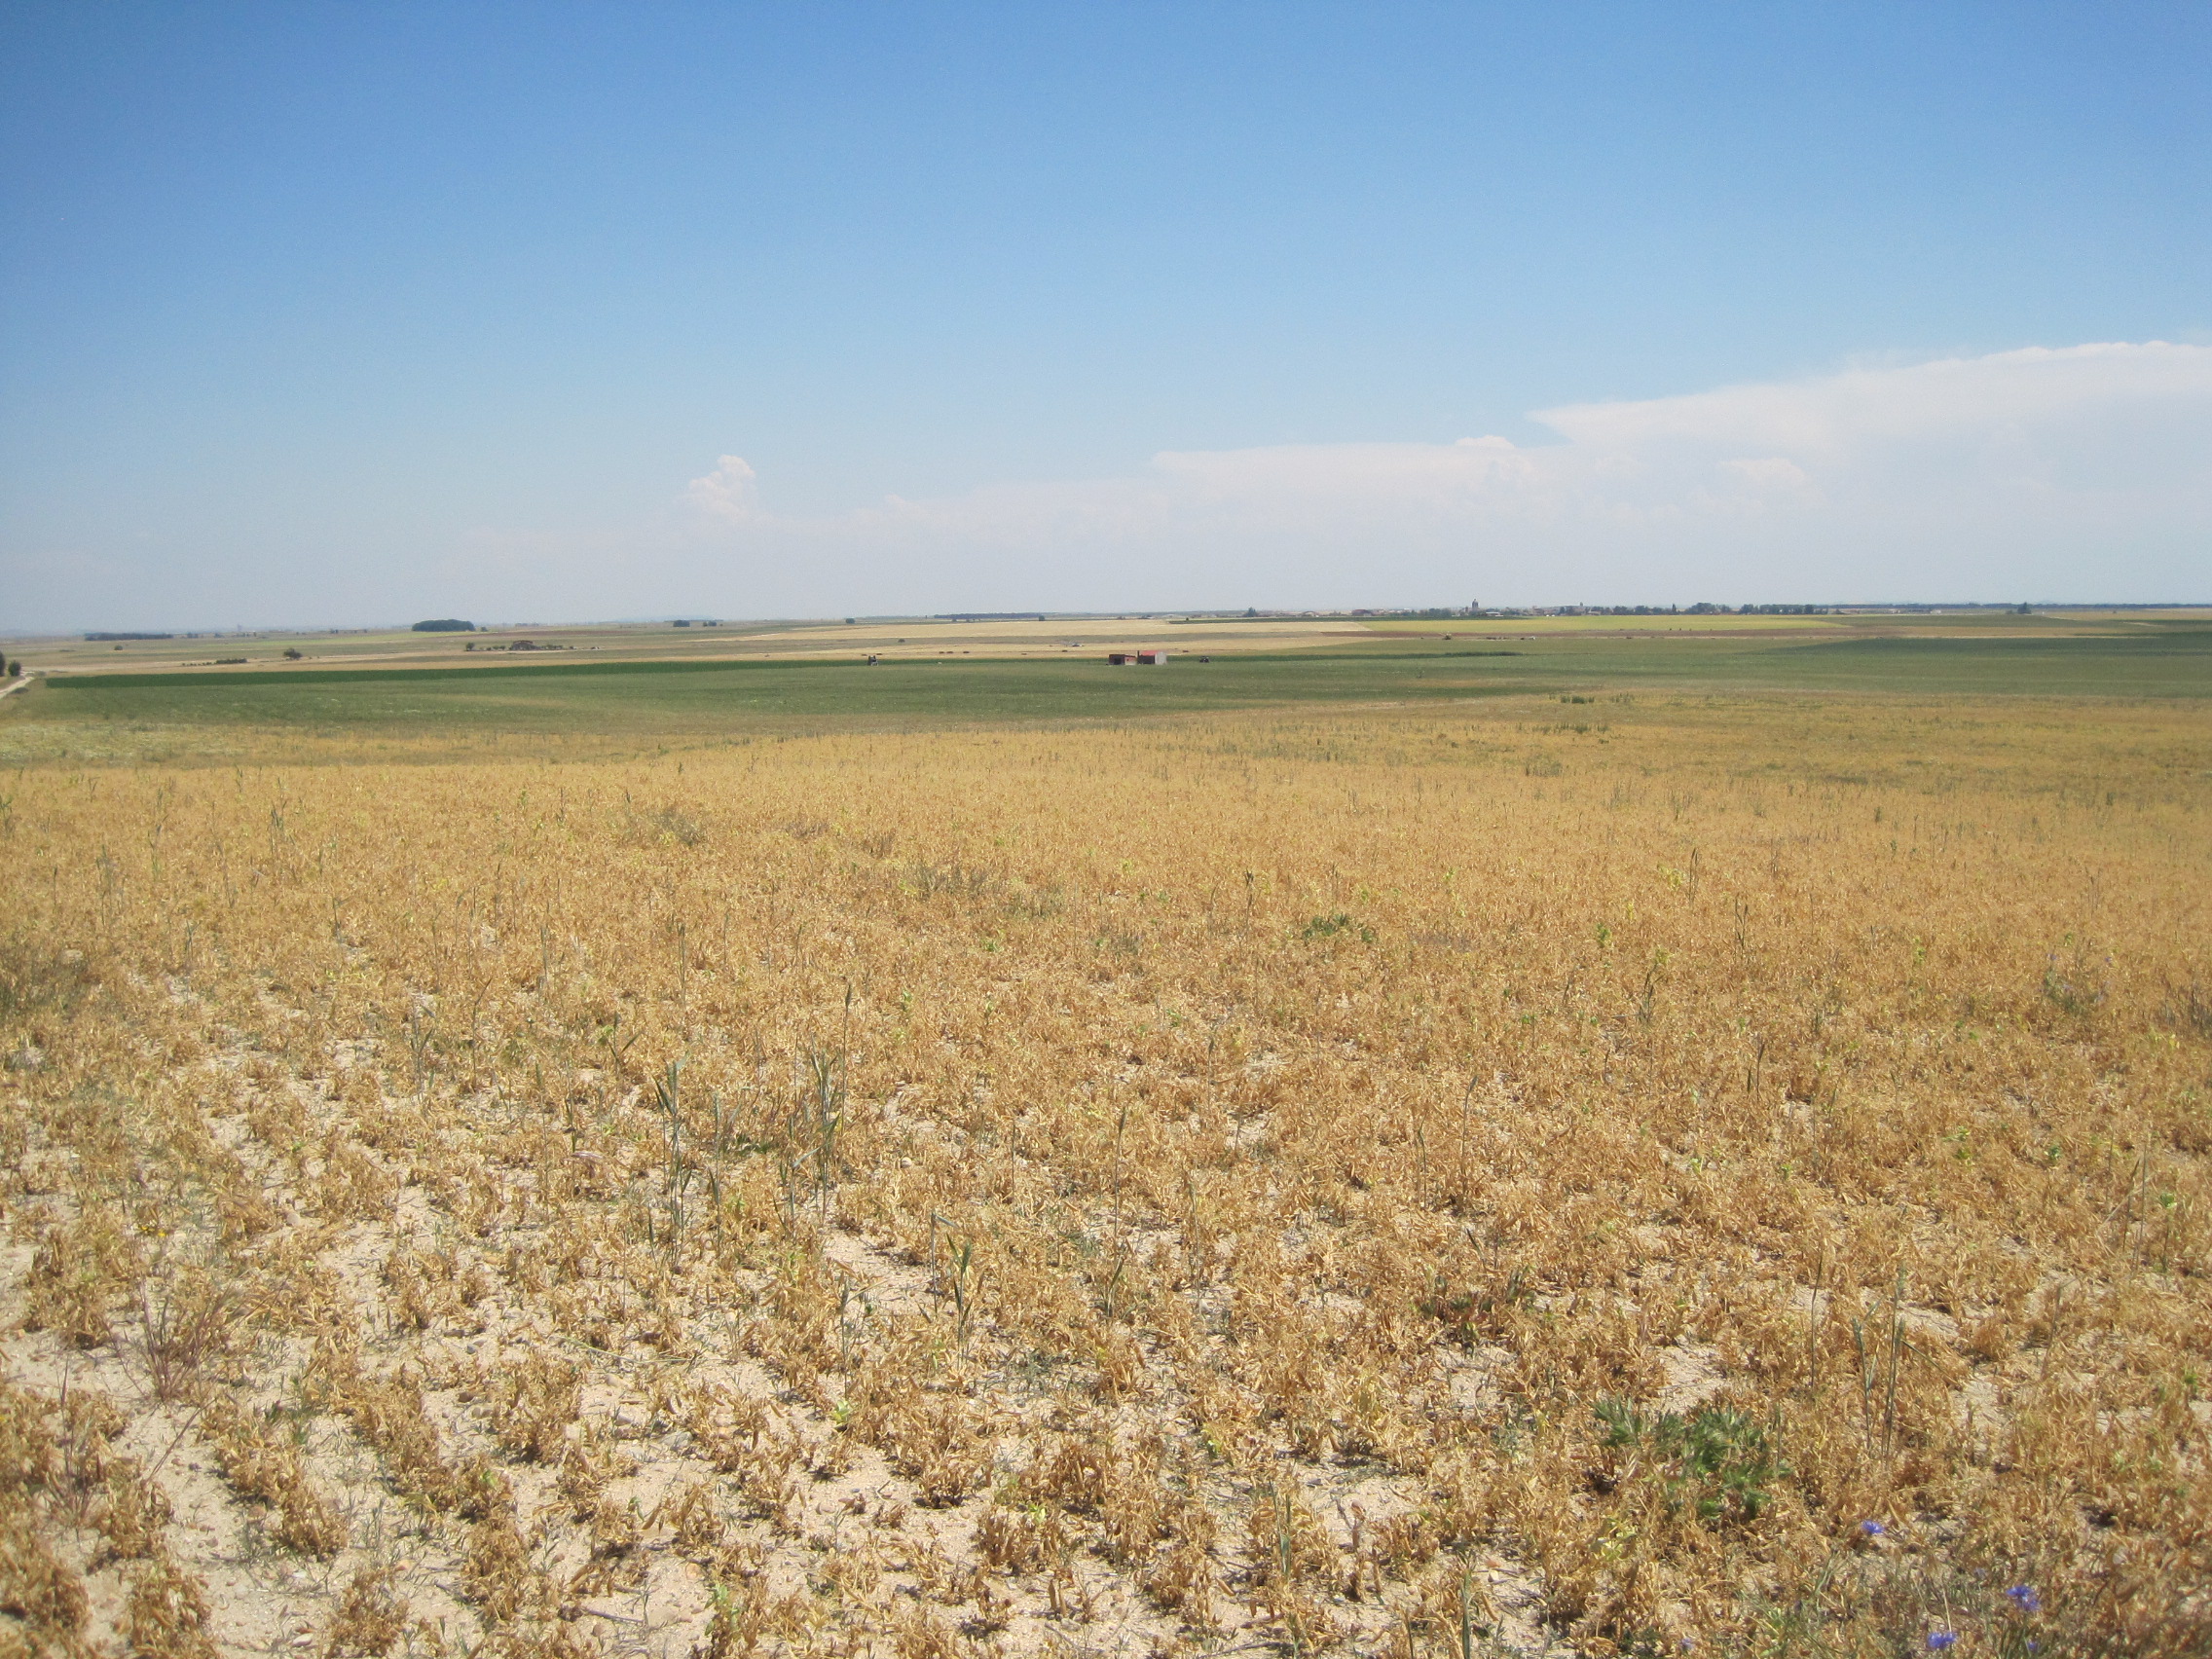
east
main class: Cropland
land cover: Dry pulses
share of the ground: > 75 %
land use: Agriculture (excluding fallow land and kitchen gardens)
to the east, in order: Dry pulses; Grass margins; Common wheat
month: May
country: ES
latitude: 41.2758
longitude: -5.1013
